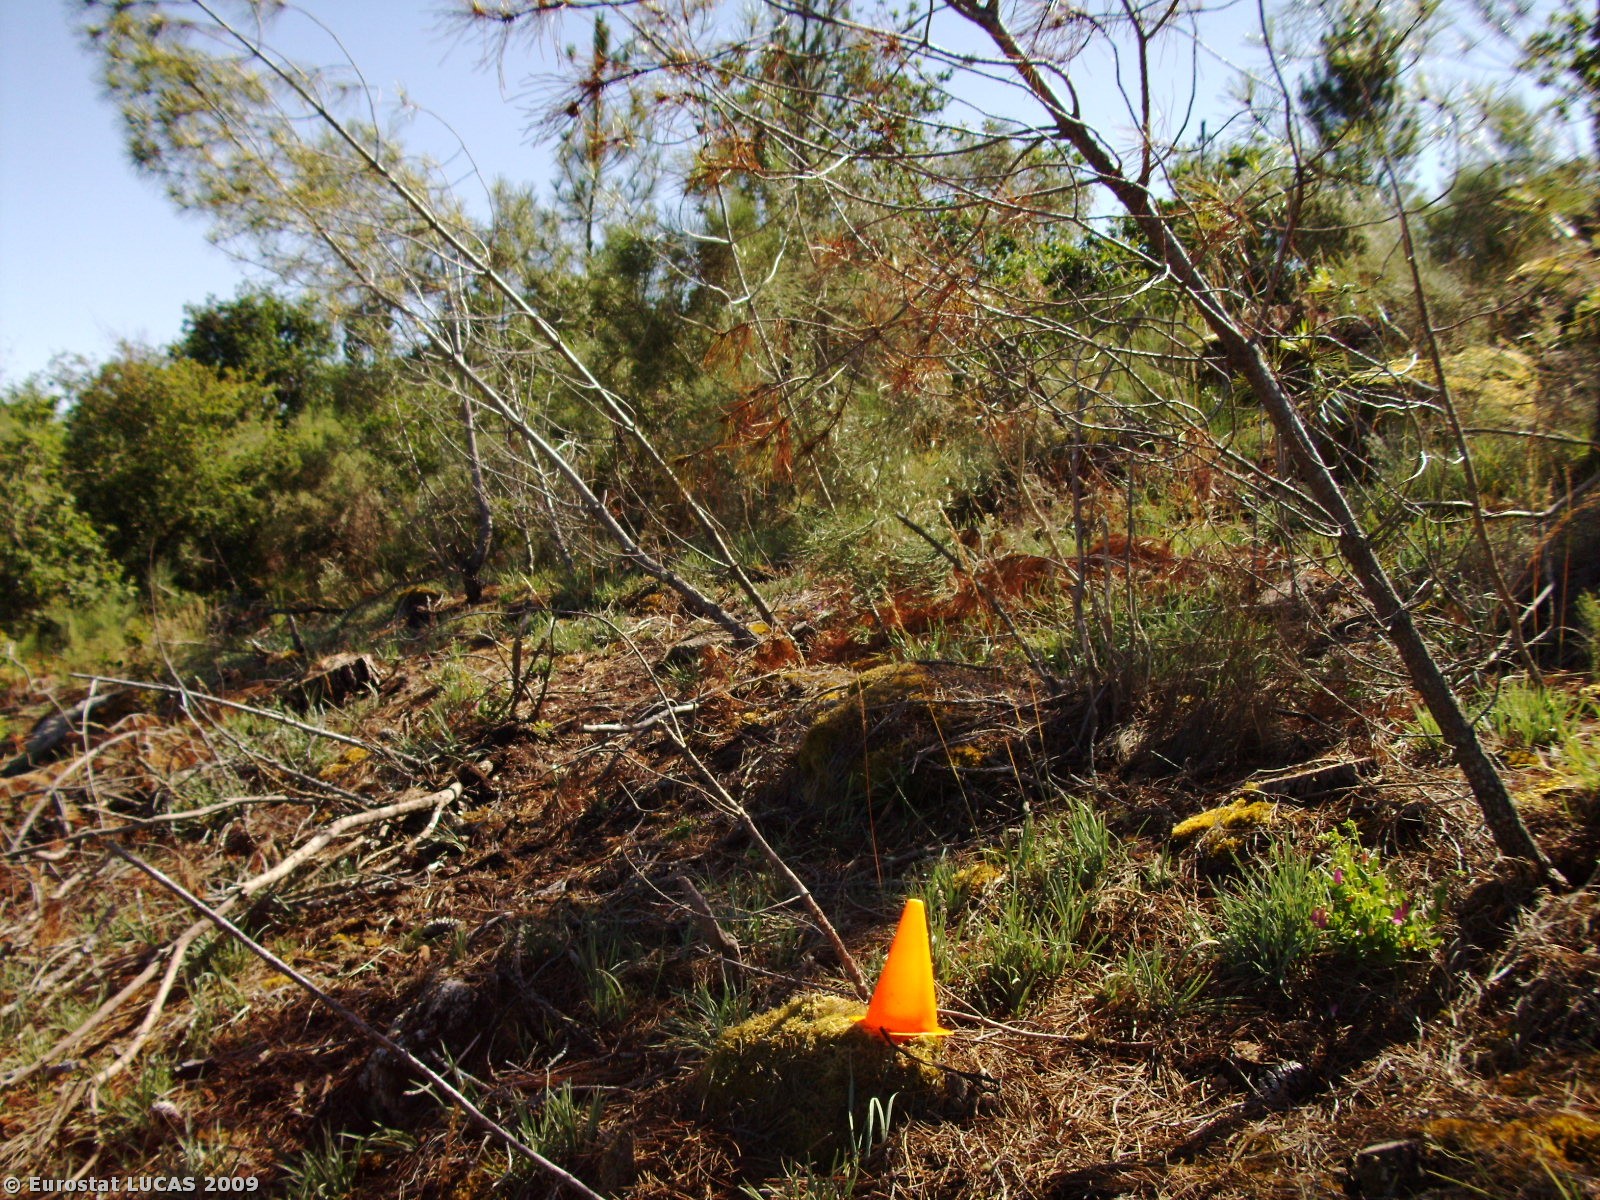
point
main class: Woodland
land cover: Coniferous woodland
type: coniferous forest of the mediterranean region
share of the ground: 10 - 25 %
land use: Forestry
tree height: > 5 m
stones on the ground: < 10 %
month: June
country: PT
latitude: 40.3968
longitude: -7.7046
